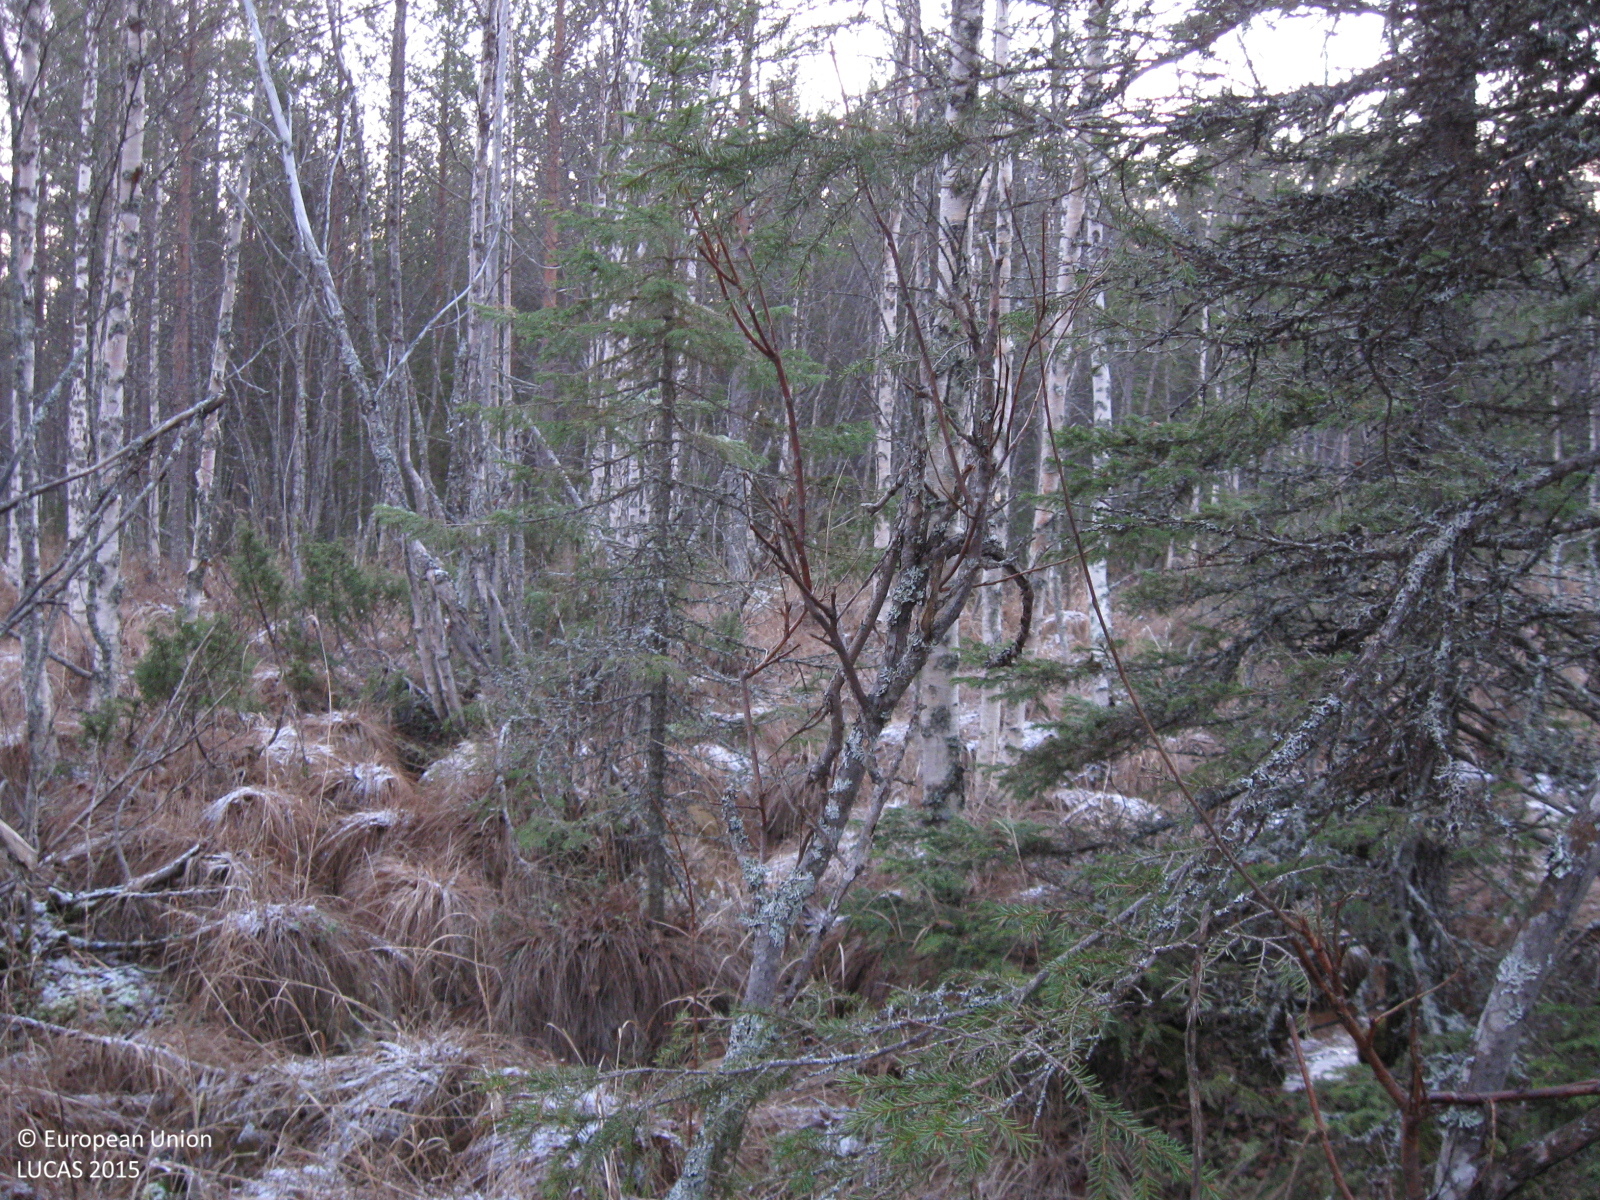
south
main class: Woodland
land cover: Spruce dominated mixed woodland
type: mire and swamp forests
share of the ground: 50 - 75 %
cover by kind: broadleaved forest trees 50 %, coniferous forest trees 20 %, herbaceous plants 20 %, shrubs 5 %, lichens and mosses 5 %
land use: Semi-natural and natural areas not in use
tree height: > 5 m
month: October
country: SE
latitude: 66.1680
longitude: 21.3433
